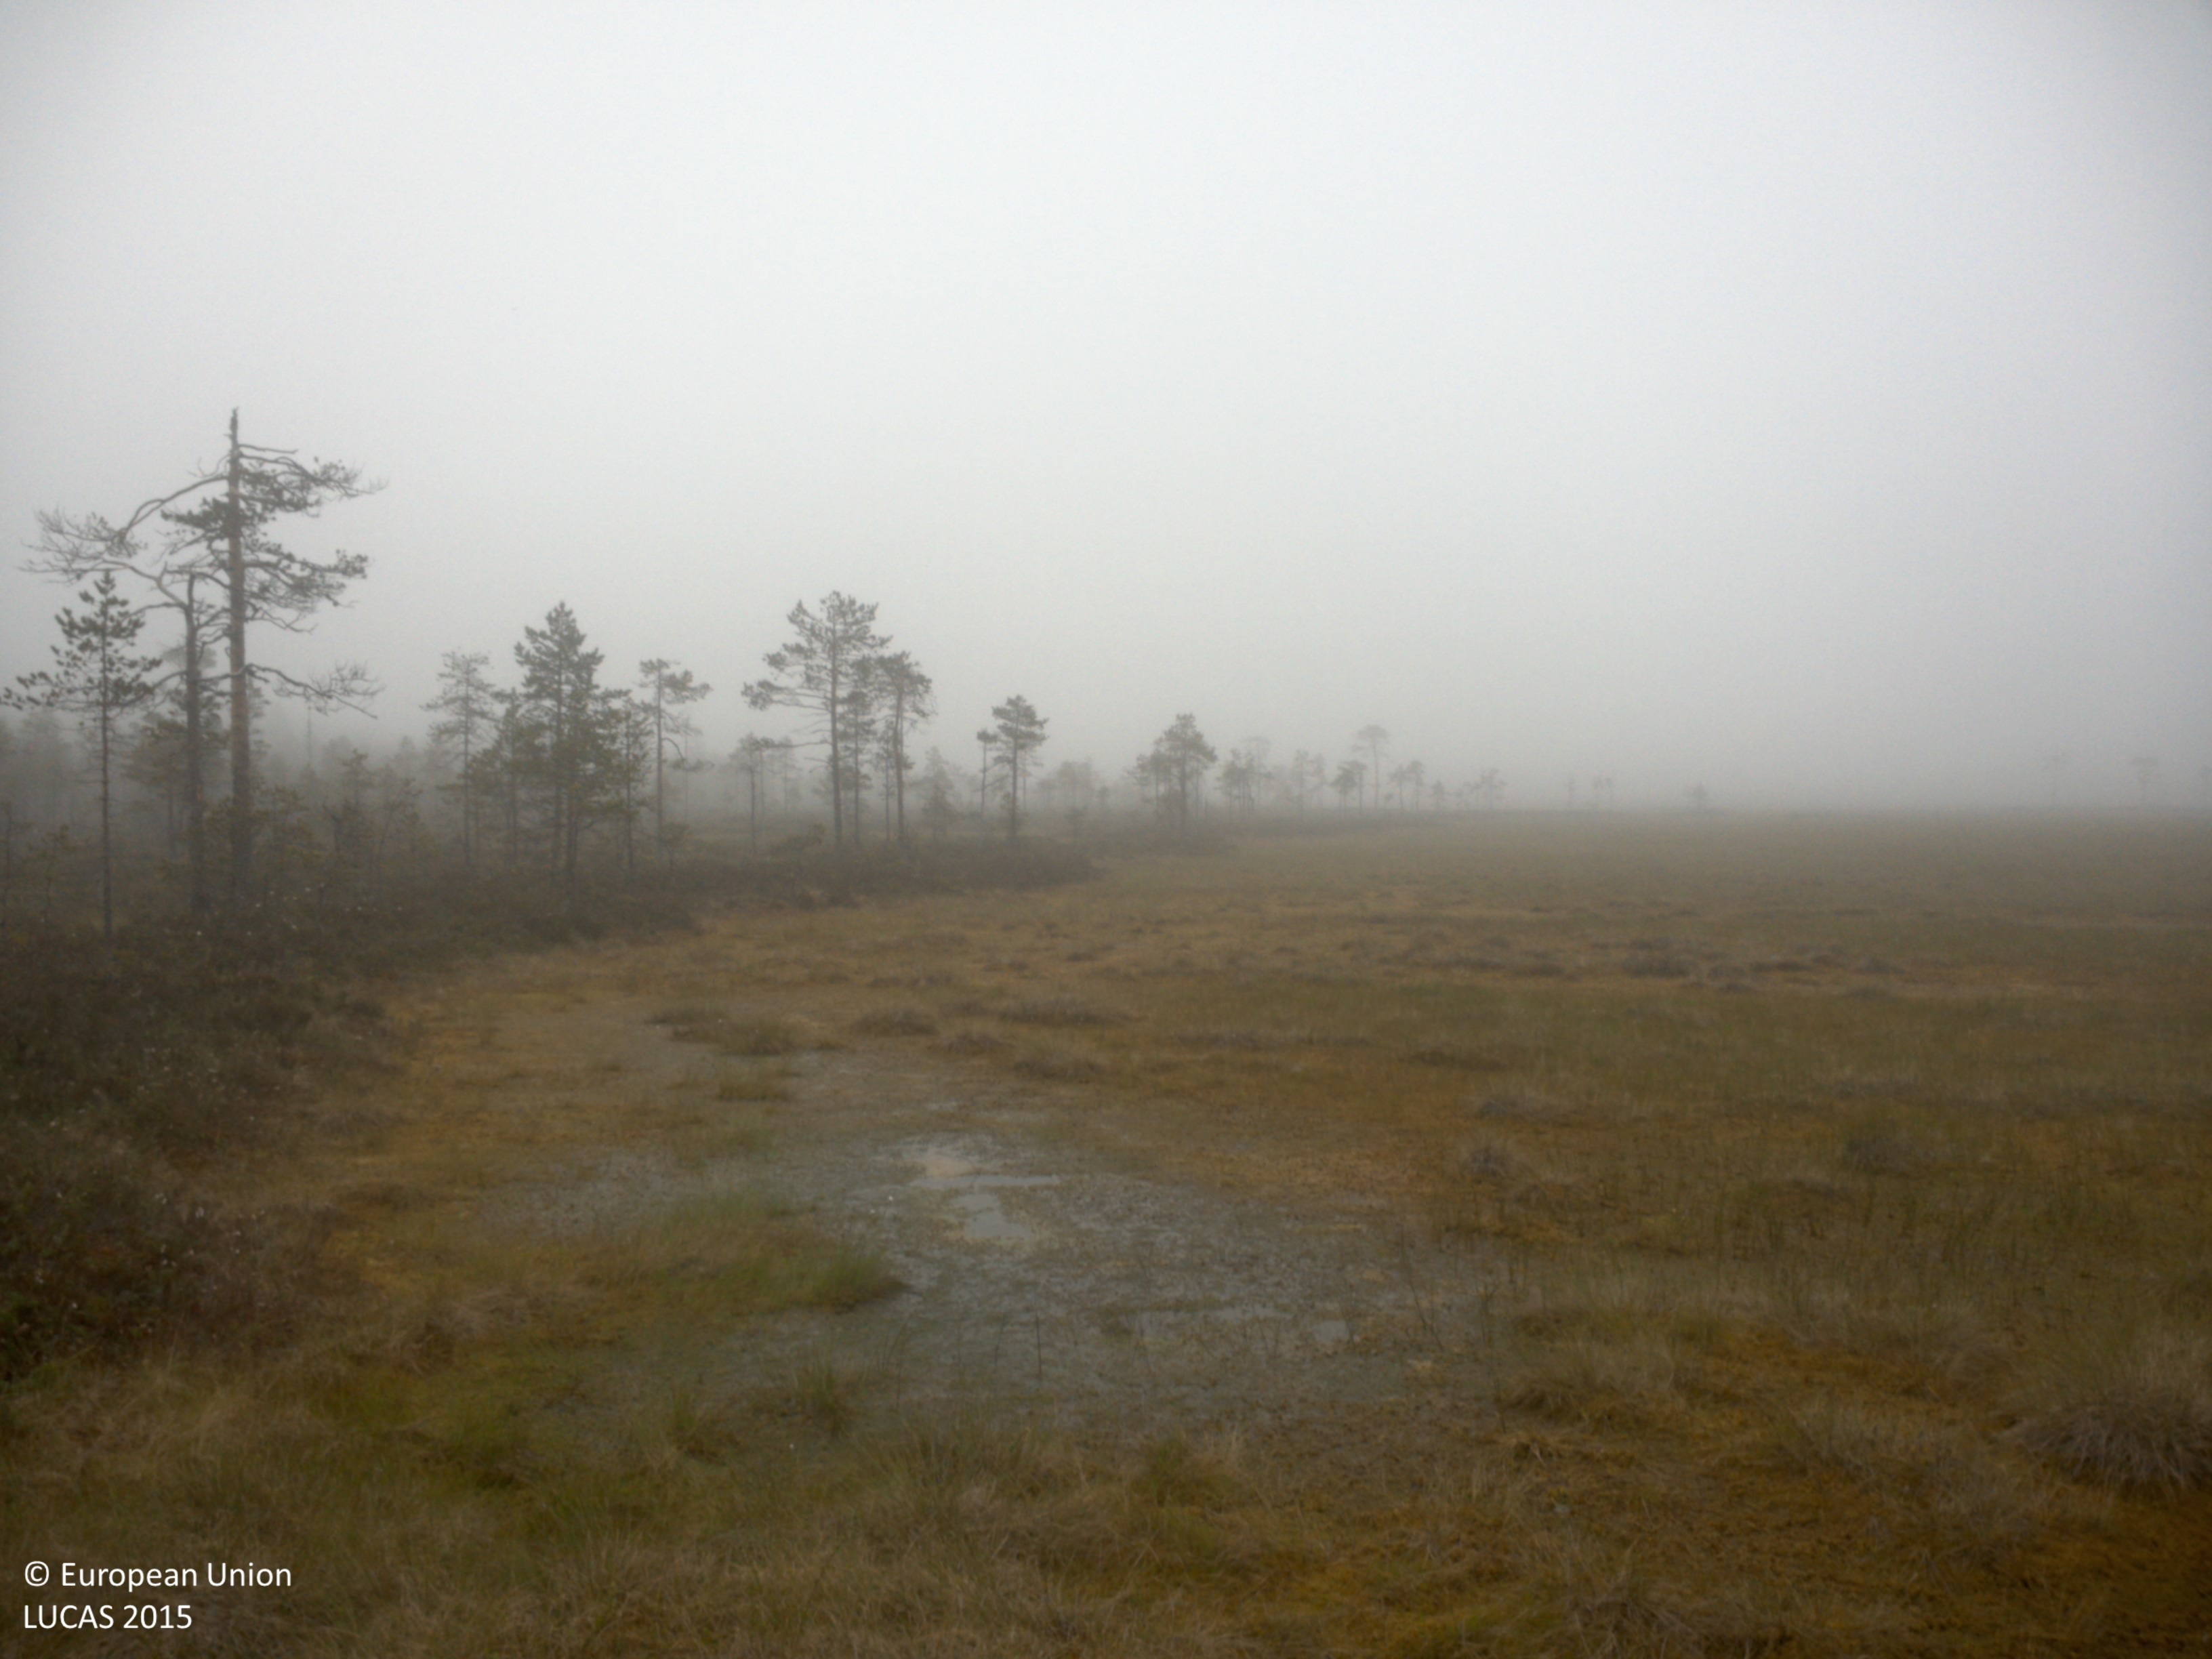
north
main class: Woodland
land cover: Pine dominated coniferous woodland
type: boreal forest
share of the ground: 10 - 25 %
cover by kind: lichens and mosses 55 %, shrubs 30 %, coniferous forest trees 15 %
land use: Semi-natural and natural areas not in use
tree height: > 5 m
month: June
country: SE
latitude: 63.6256
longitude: 19.7255
